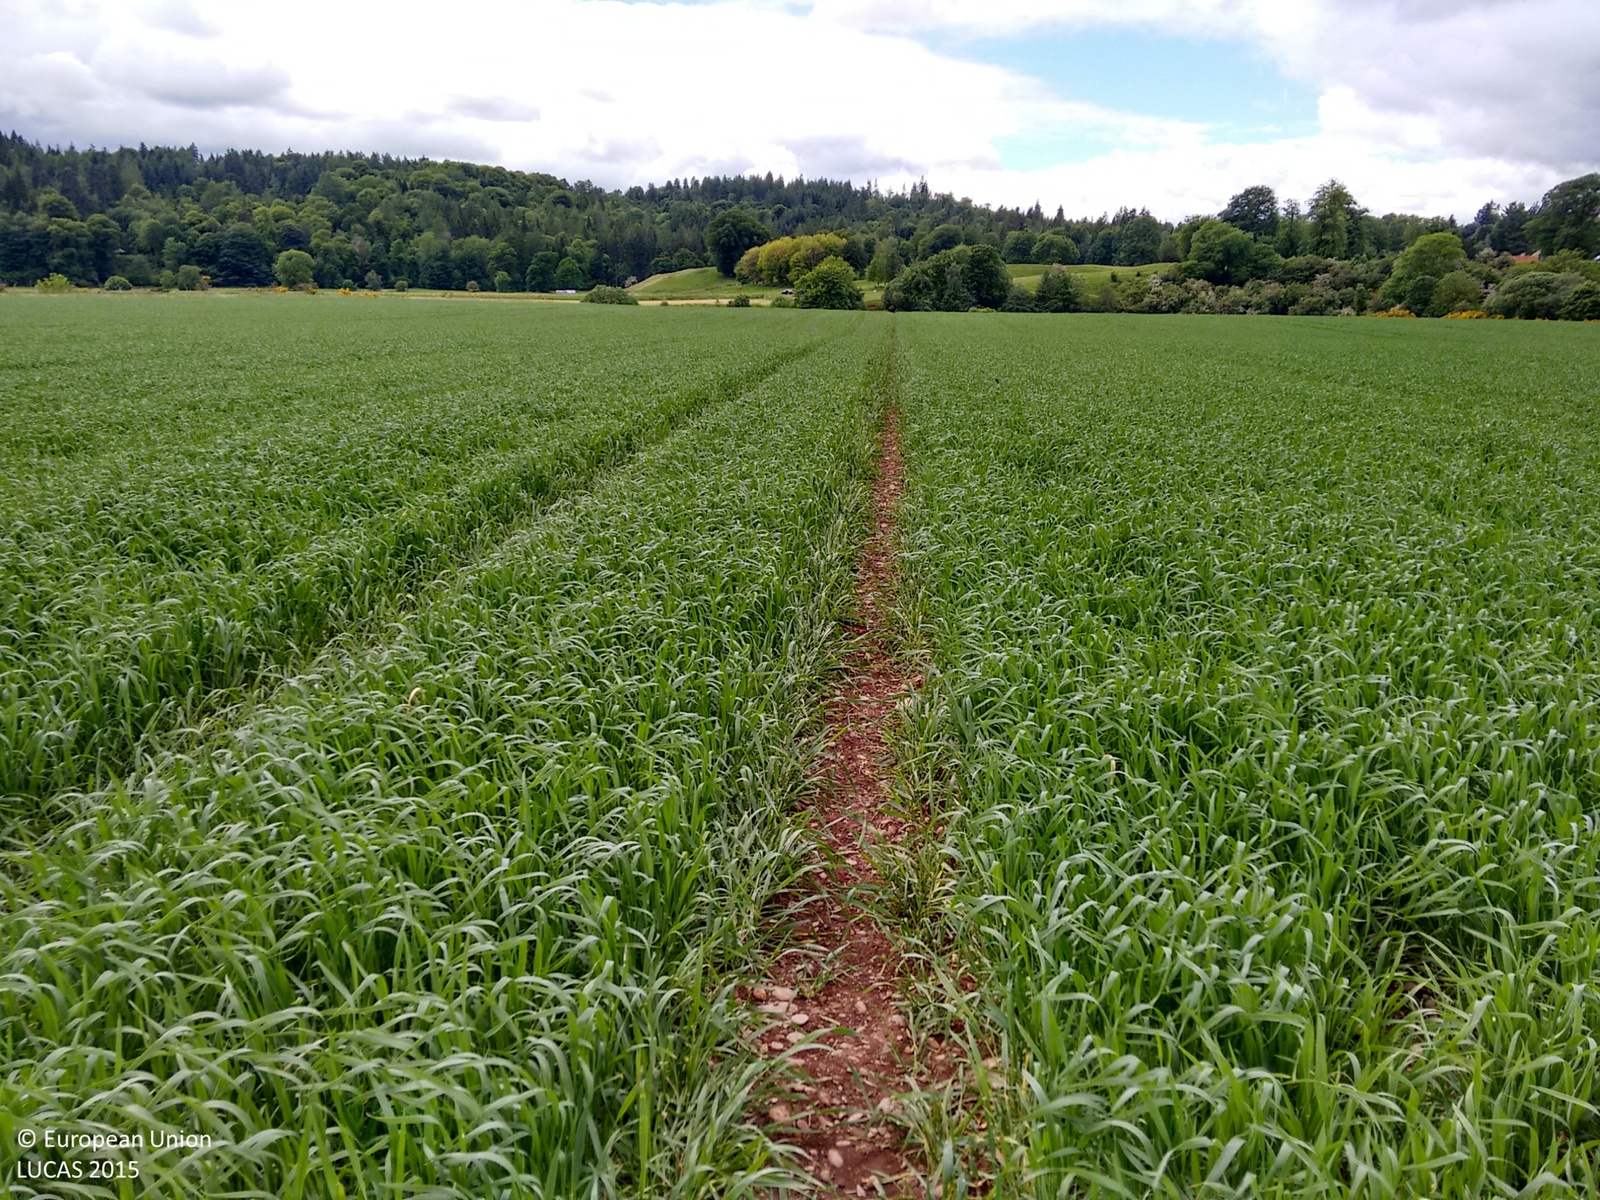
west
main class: Cropland
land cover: Barley
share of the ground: > 75 %
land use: Agriculture (excluding fallow land and kitchen gardens)
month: June
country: GB
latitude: 55.2733
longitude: -3.7955
